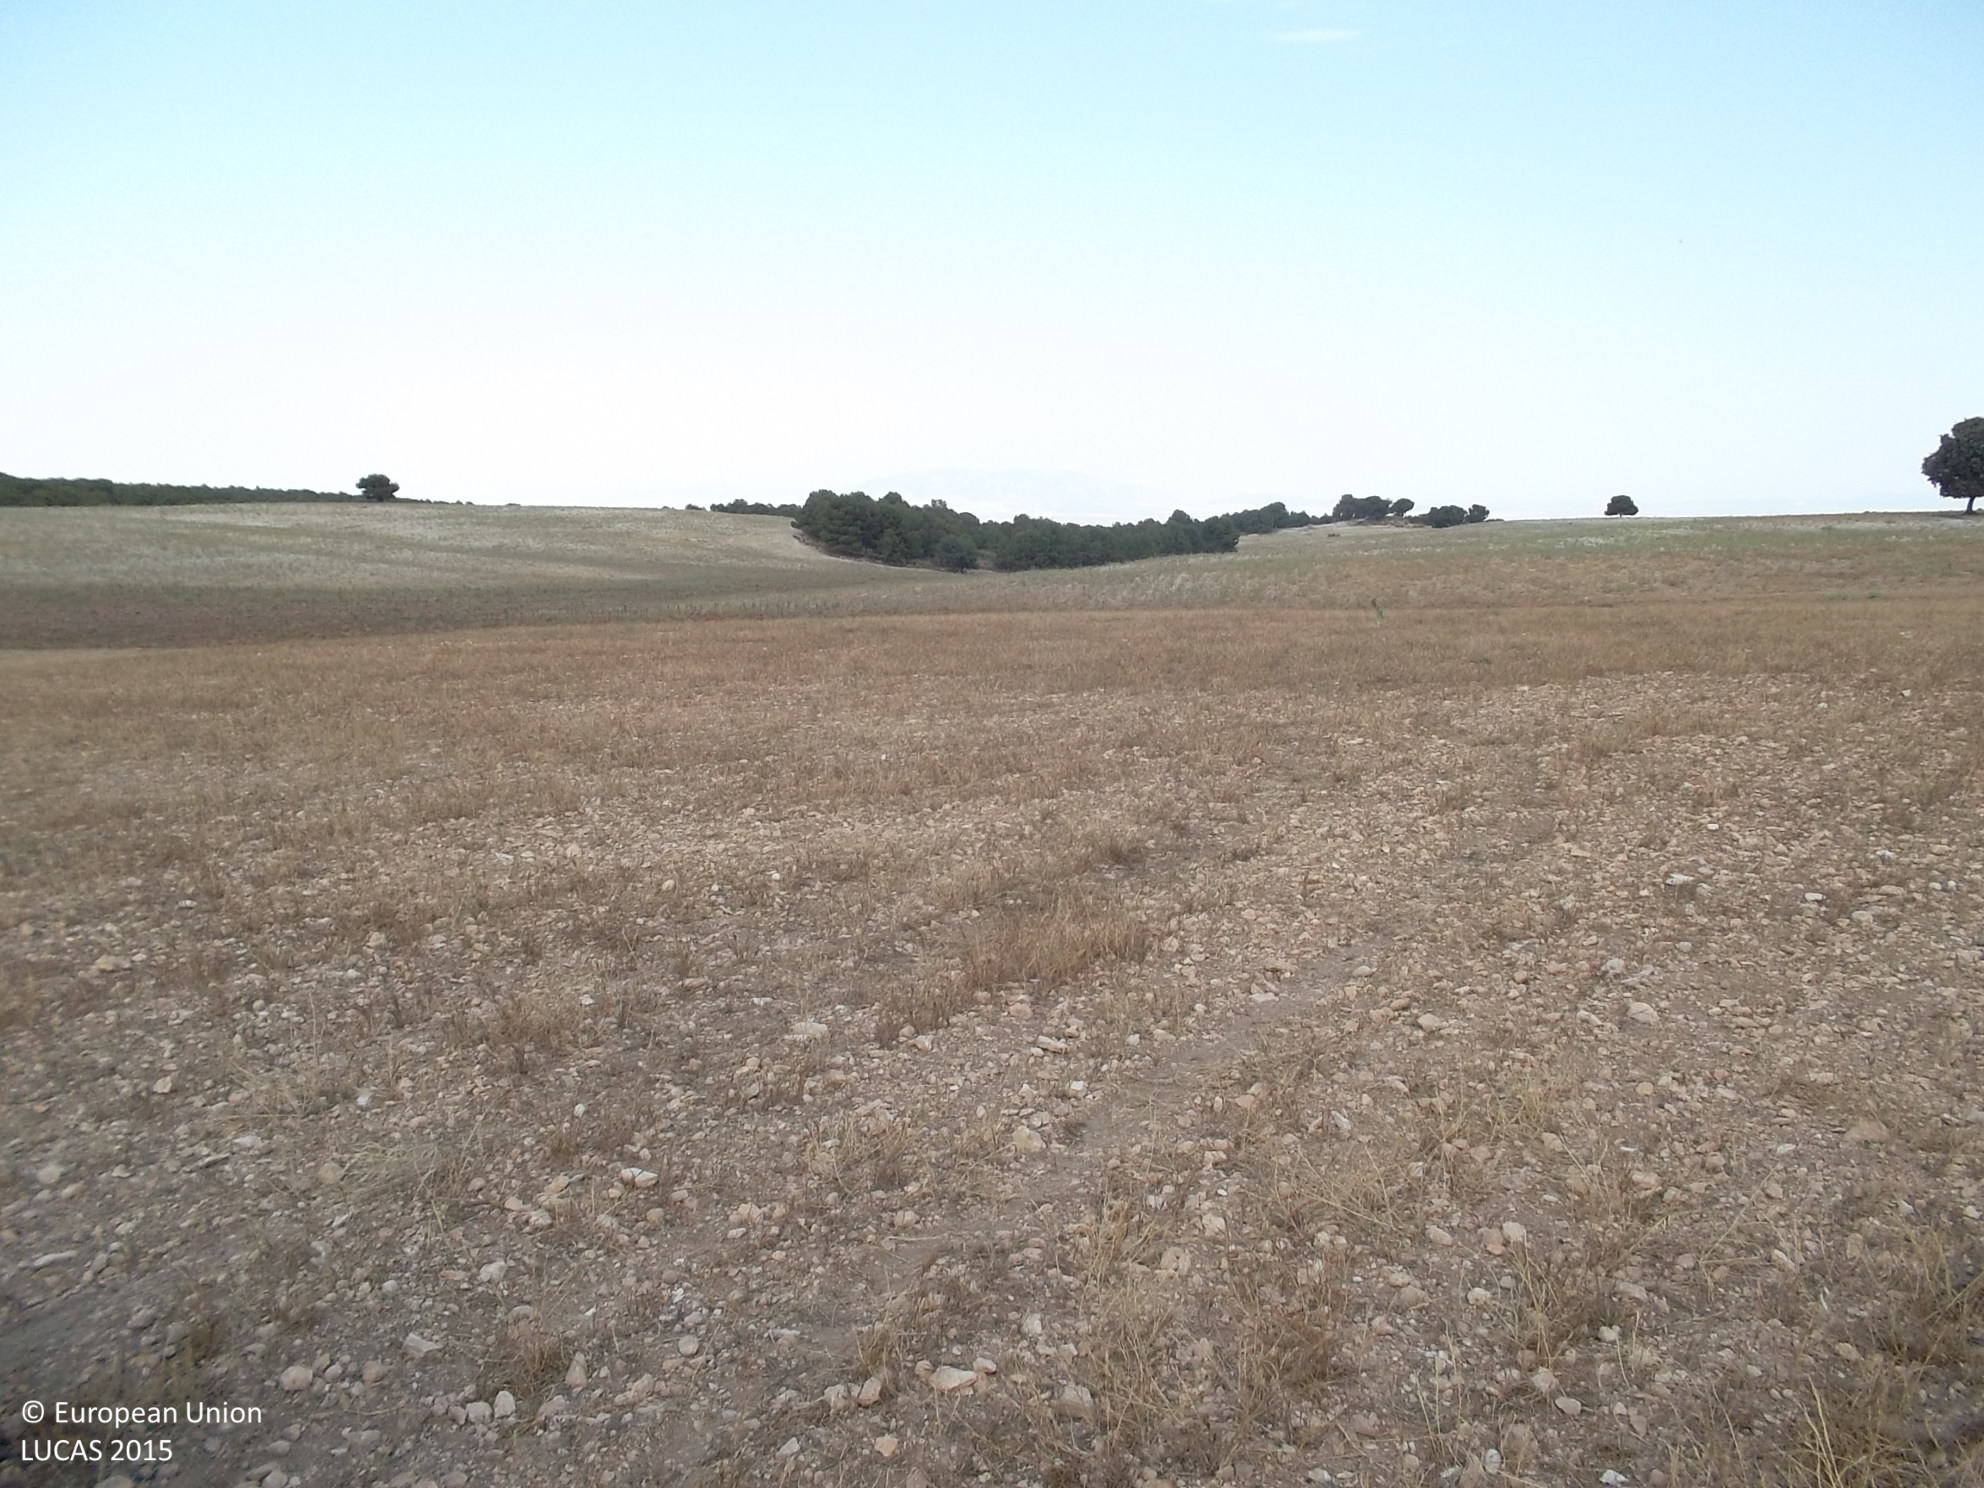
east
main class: Grassland
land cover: Grassland without tree/shrub cover
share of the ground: 25 - 50 %
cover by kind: unconsolidated bare surface 75 %, herbaceous plants 25 %
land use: Abandoned areas
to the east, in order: Grassland without tree/shrub cover; Tracks; Grassland without tree/shrub cover
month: July
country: ES
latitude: 37.7103
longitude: -2.7515
